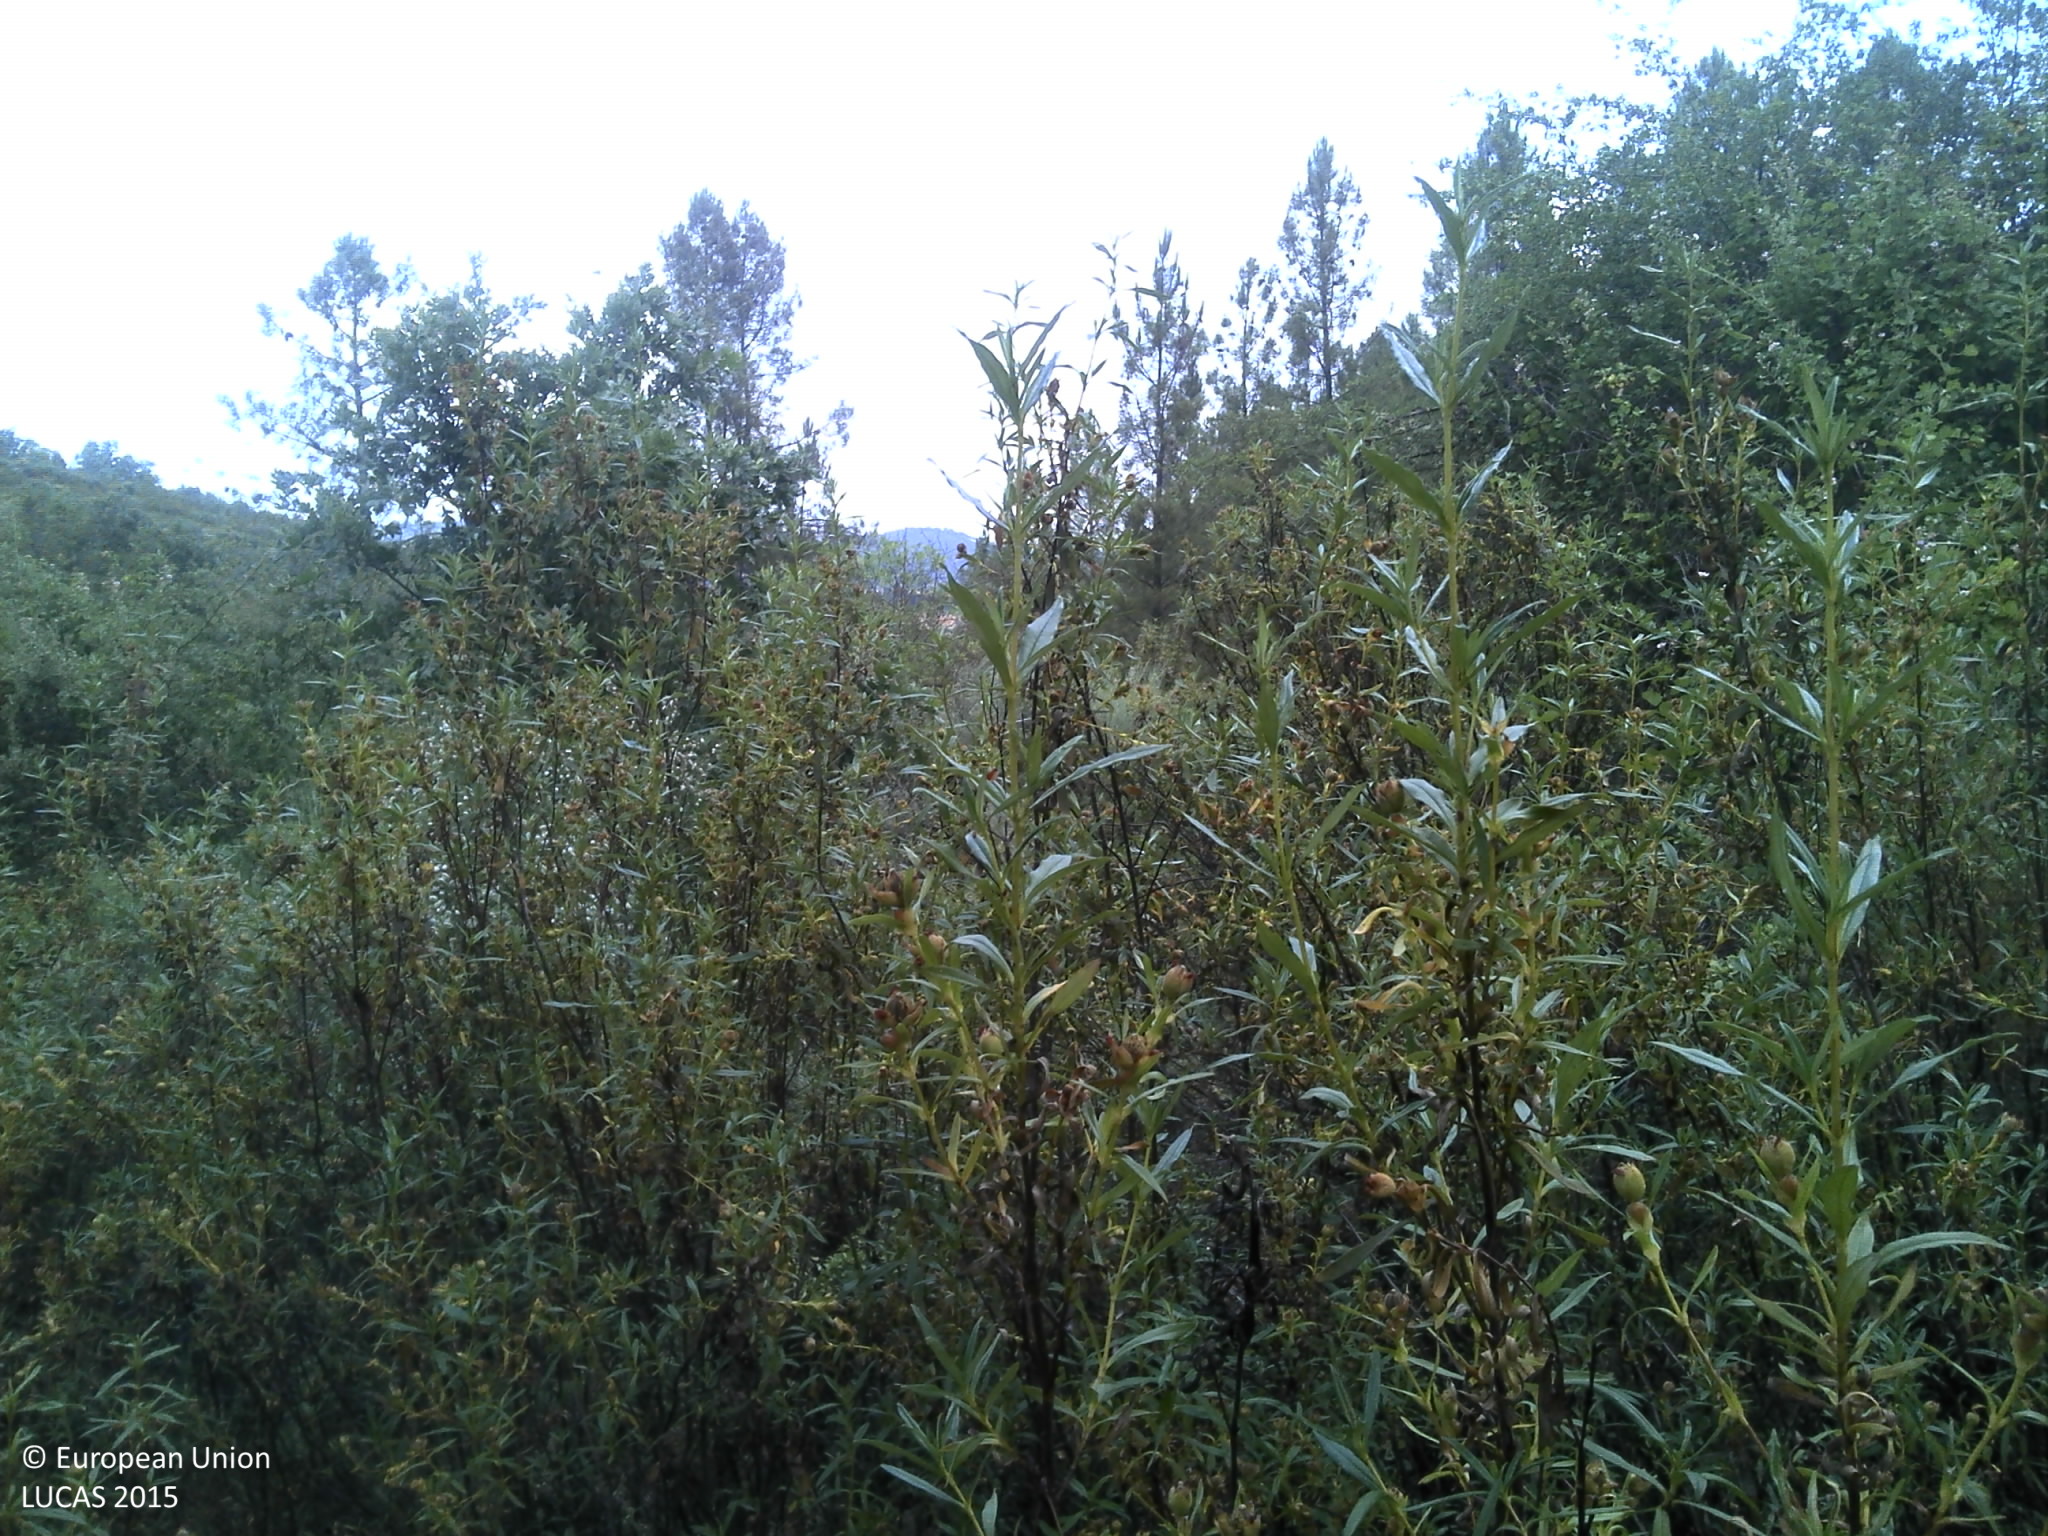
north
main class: Woodland
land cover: Pine dominated coniferous woodland
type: coniferous forest of the mediterranean region
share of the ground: 50 - 75 %
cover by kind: coniferous forest trees 60 %, shrubs 30 %, unconsolidated bare surface 5 %
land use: Forestry
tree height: > 5 m
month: June
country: PT
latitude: 40.2133
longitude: -7.2911
